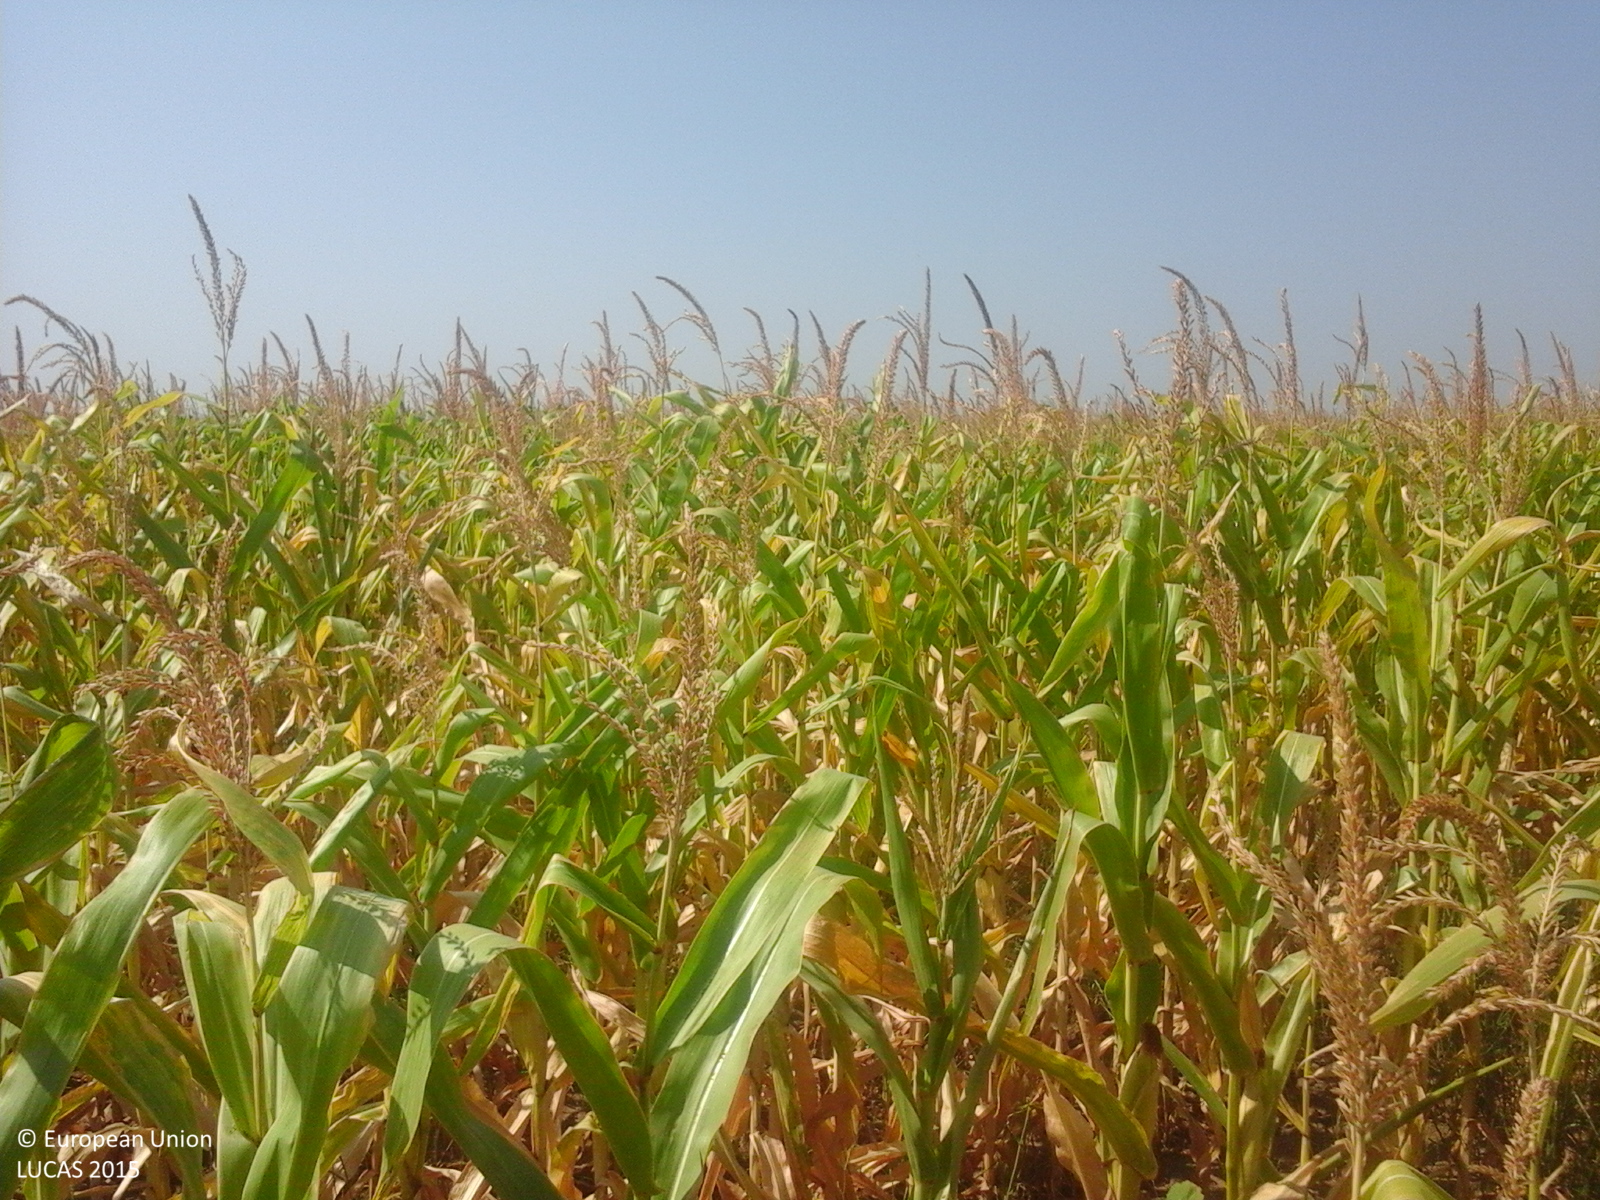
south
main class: Cropland
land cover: Maize
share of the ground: > 75 %
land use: Agriculture (excluding fallow land and kitchen gardens)
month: August
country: RO
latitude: 45.7420
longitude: 27.4942
